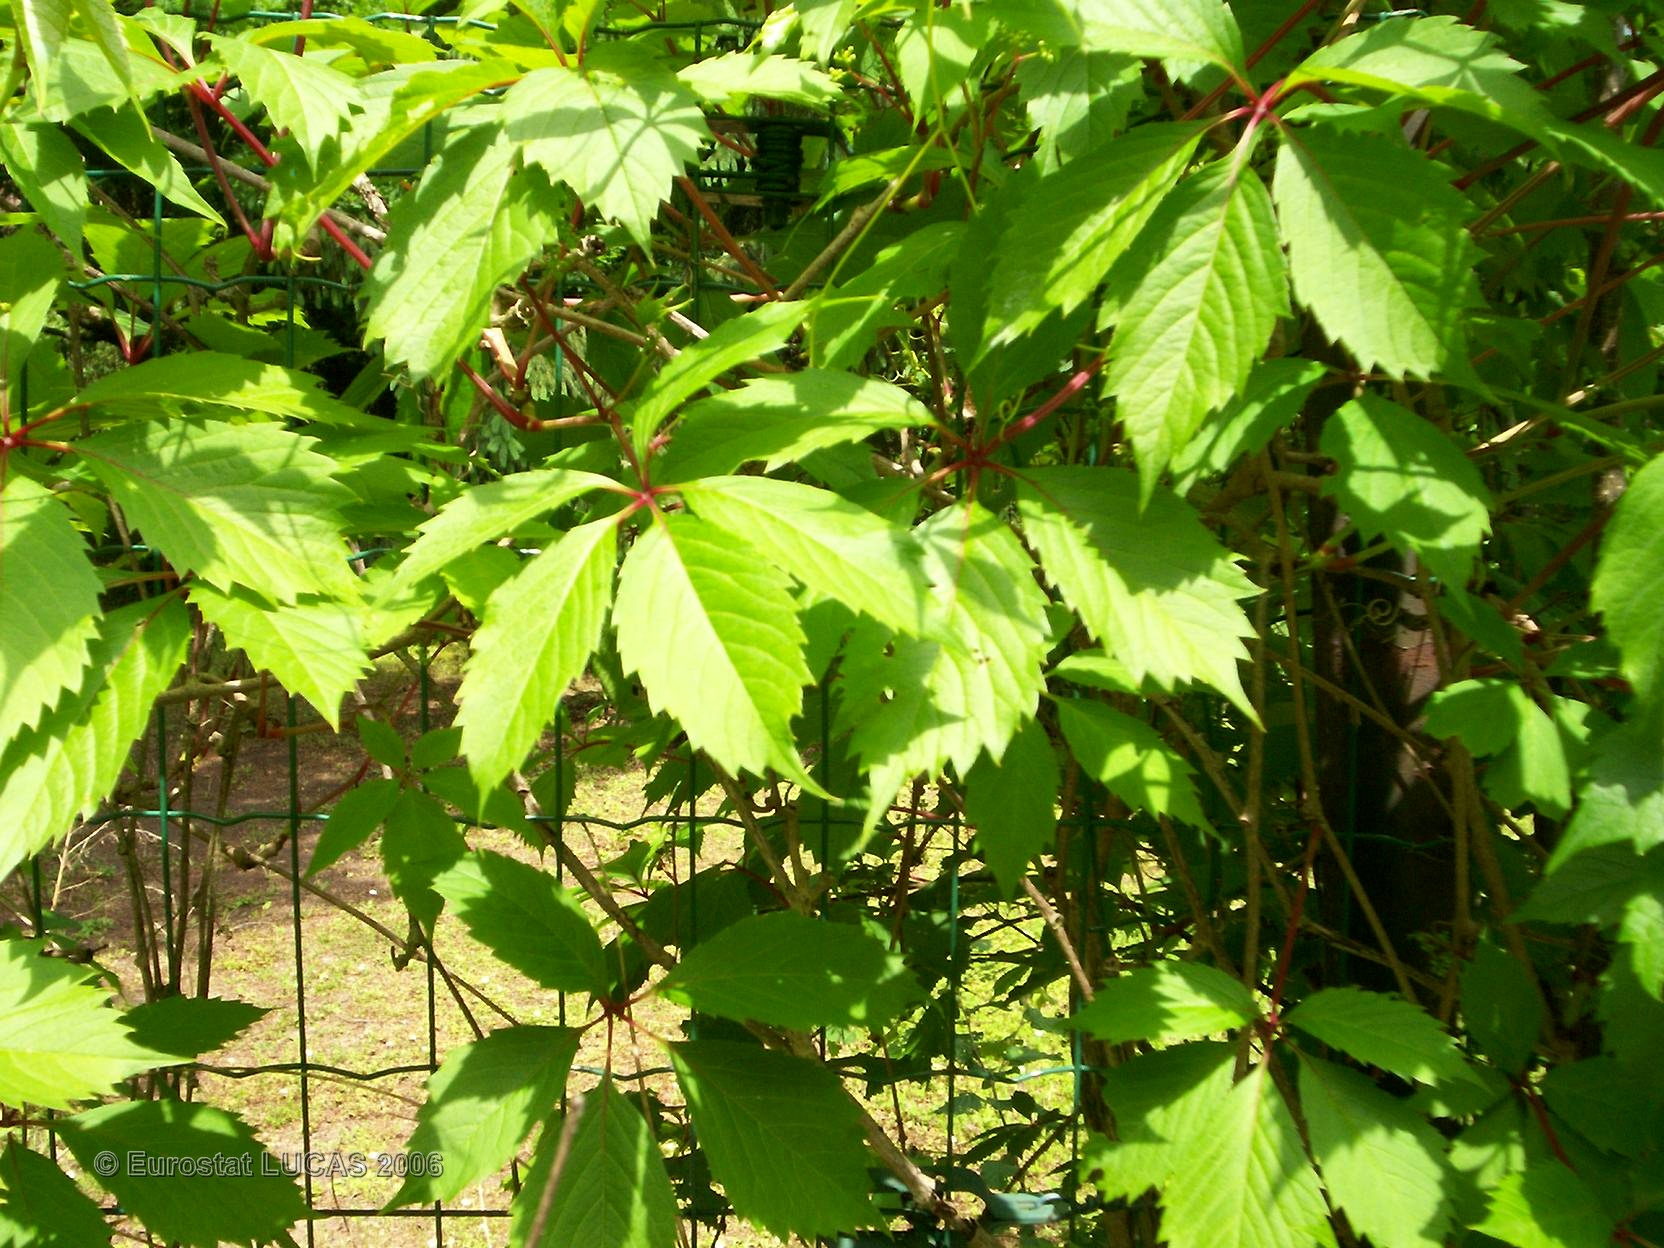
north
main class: Grassland
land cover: Grassland with sparse tree/shrub cover
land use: Residential
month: May
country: FR
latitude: 48.4548
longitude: 2.7567
